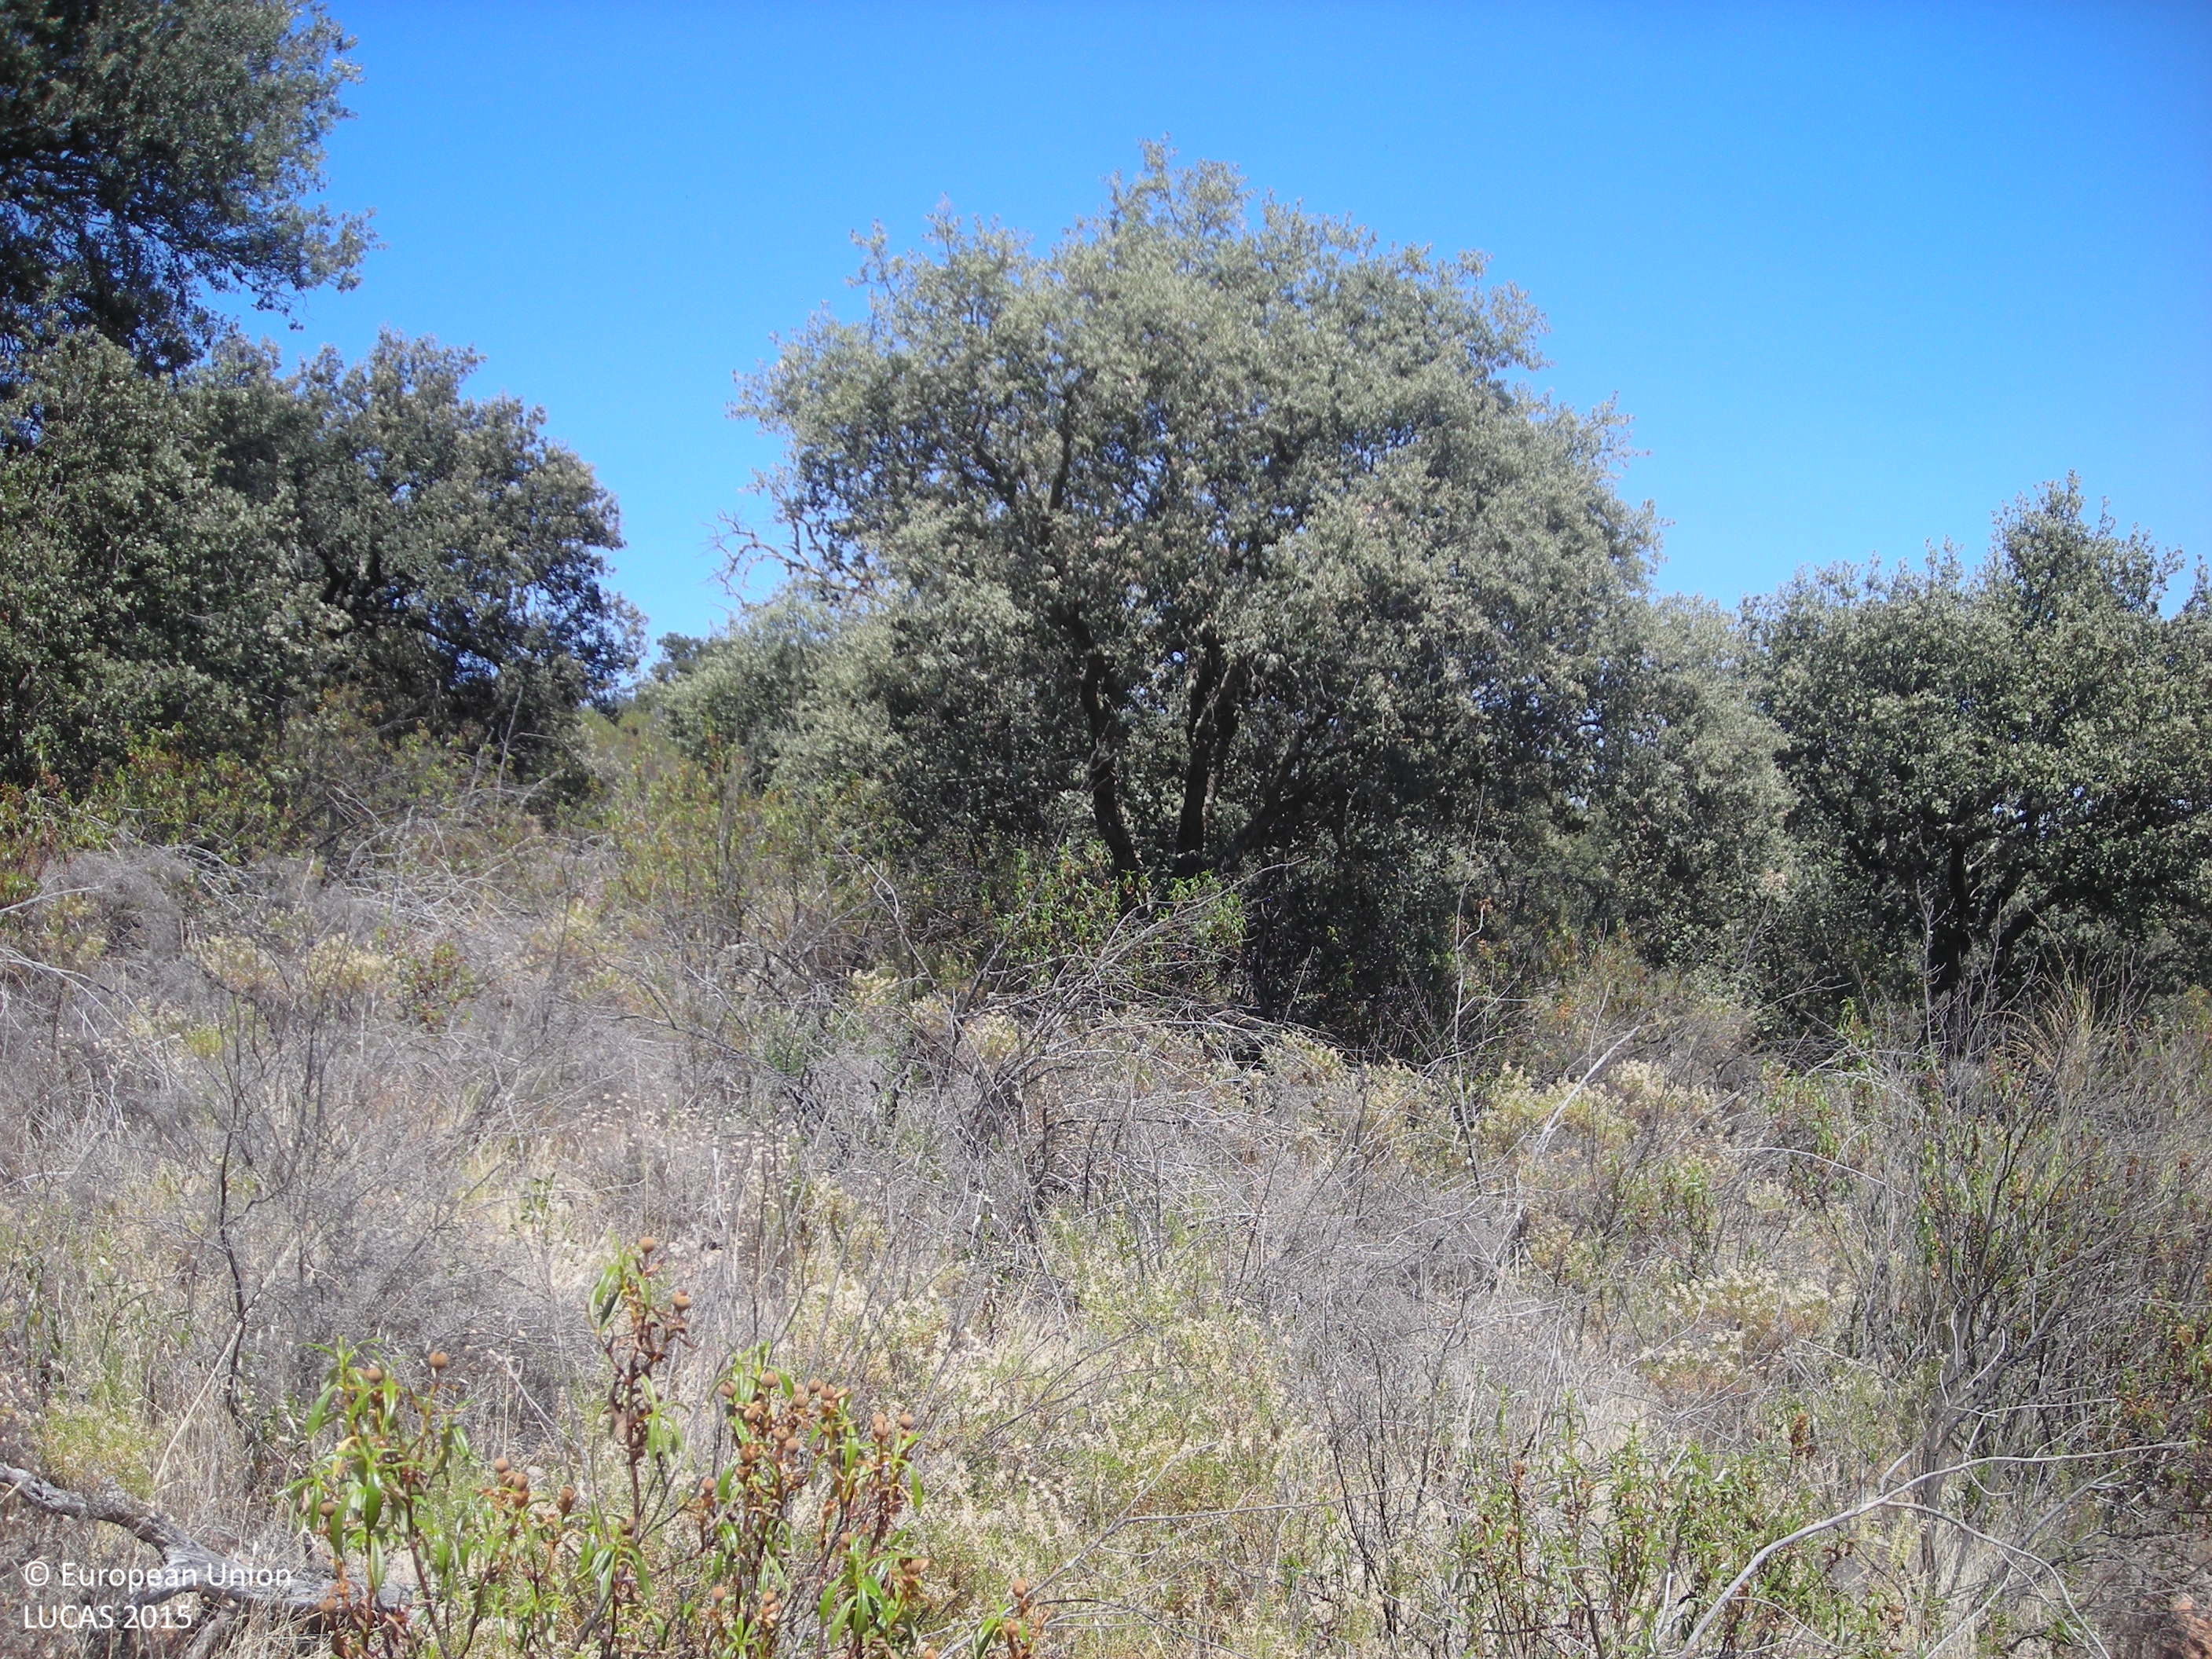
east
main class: Shrubland
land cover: Shrubland with sparse tree cover
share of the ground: > 75 %
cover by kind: shrubs 95 %, broadleaved forest trees 5 %
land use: Semi-natural and natural areas not in use
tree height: > 5 m
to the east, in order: Shrubland with sparse tree cover
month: June
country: ES
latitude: 38.6437
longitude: -5.8180
